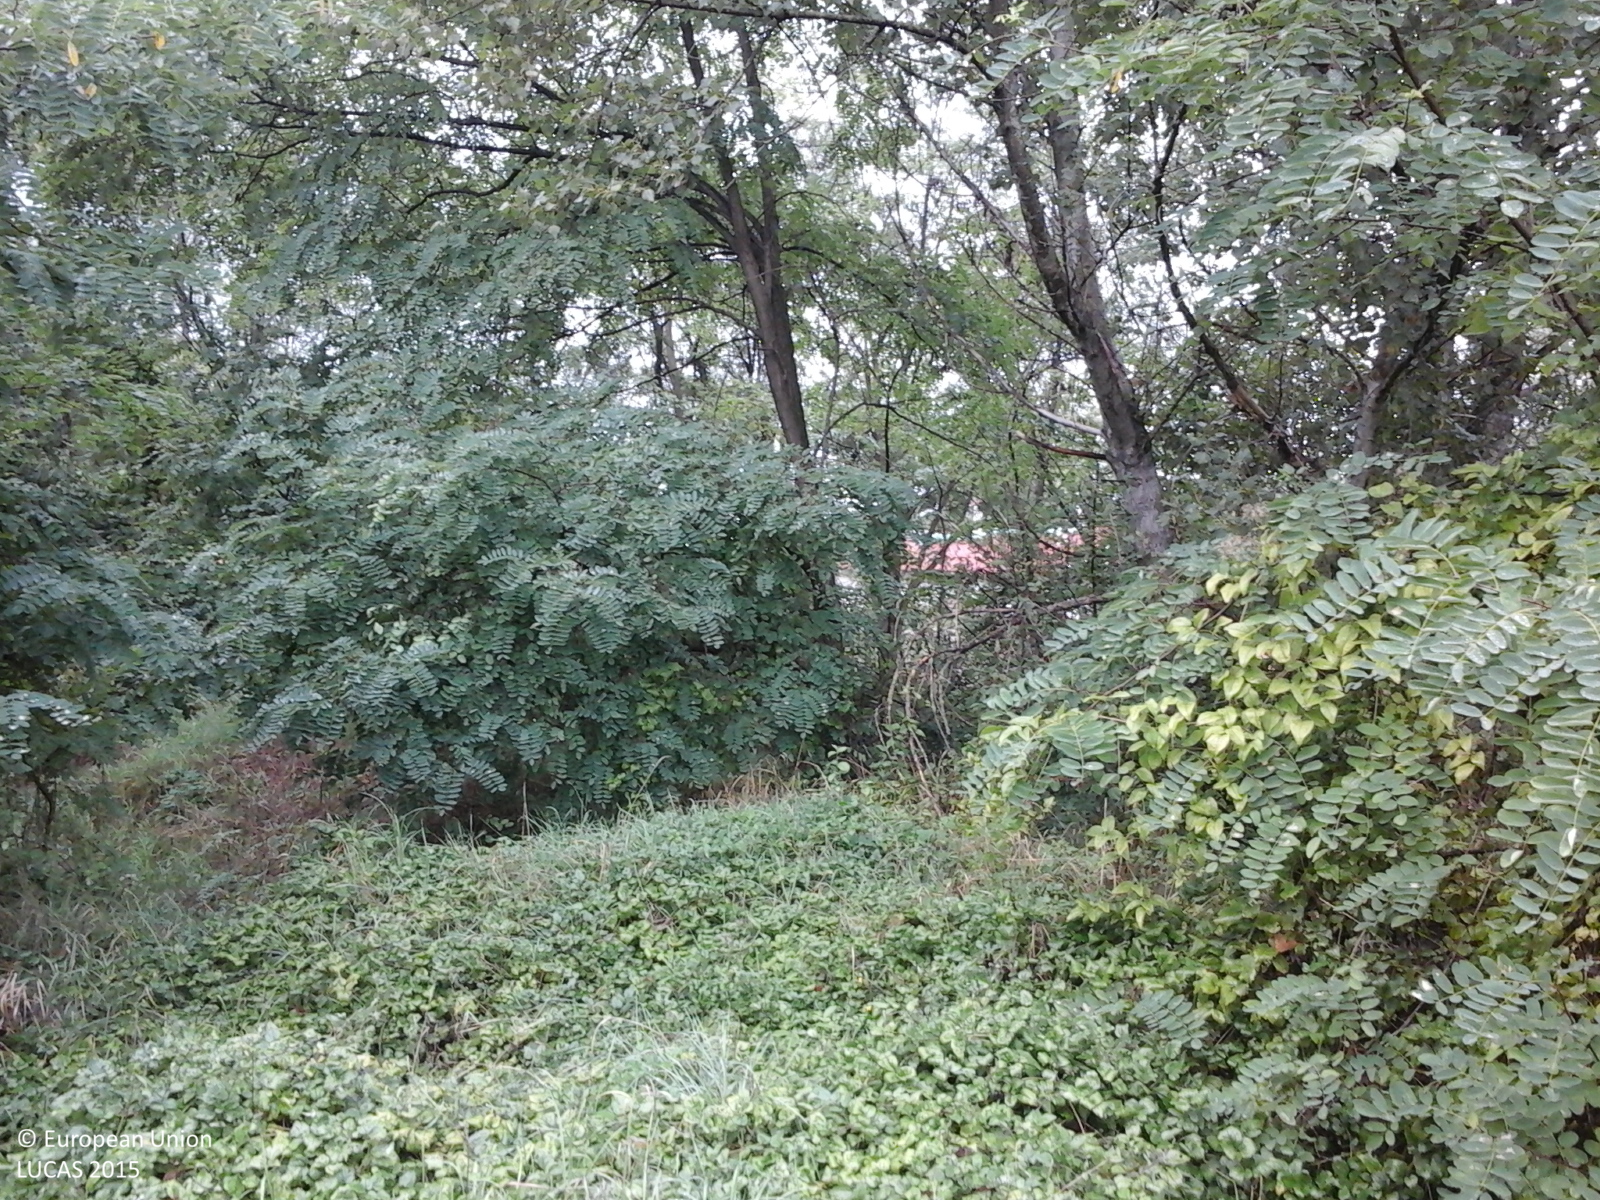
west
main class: Woodland
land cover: Broadleaved woodland
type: exotic forest
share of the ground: > 75 %
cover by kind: broadleaved forest trees 100 %
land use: Forestry
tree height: > 5 m
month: September
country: RO
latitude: 47.0157
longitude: 22.5123
